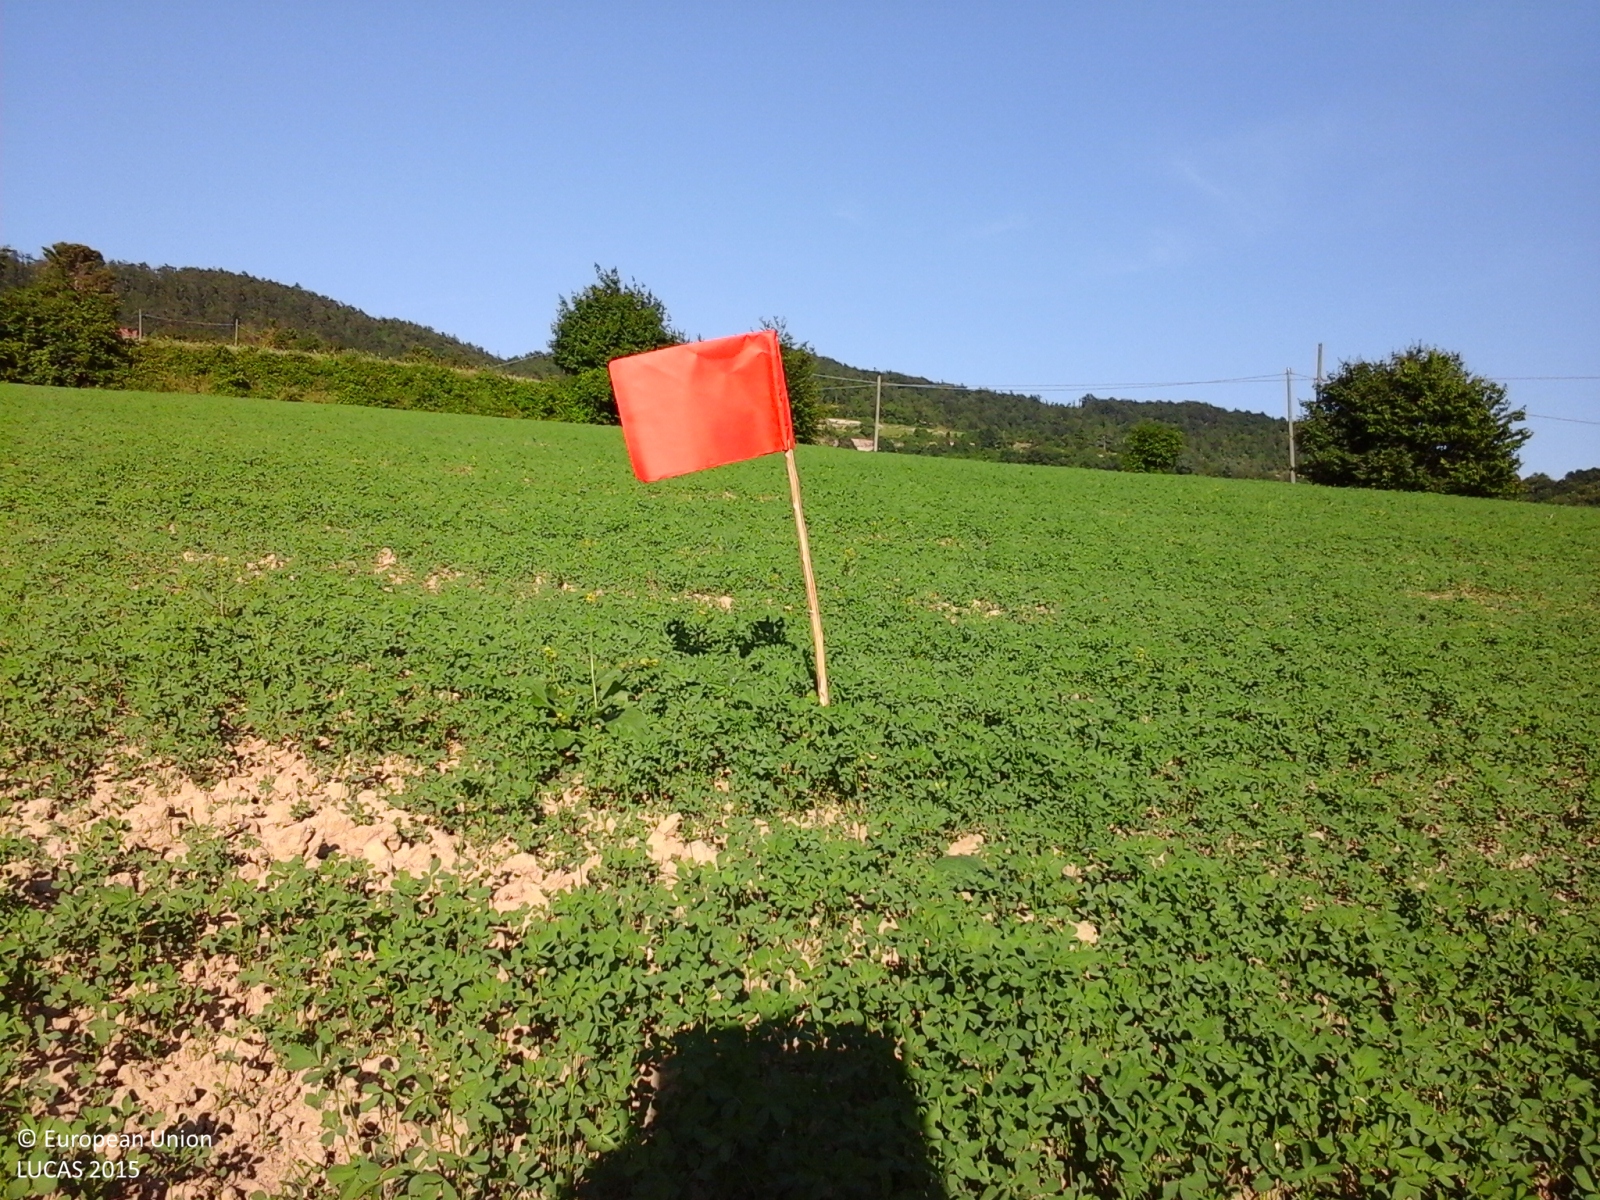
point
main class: Cropland
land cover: Lucerne
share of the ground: > 75 %
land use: Agriculture (excluding fallow land and kitchen gardens)
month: June
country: IT
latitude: 44.5523
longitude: 8.2539
